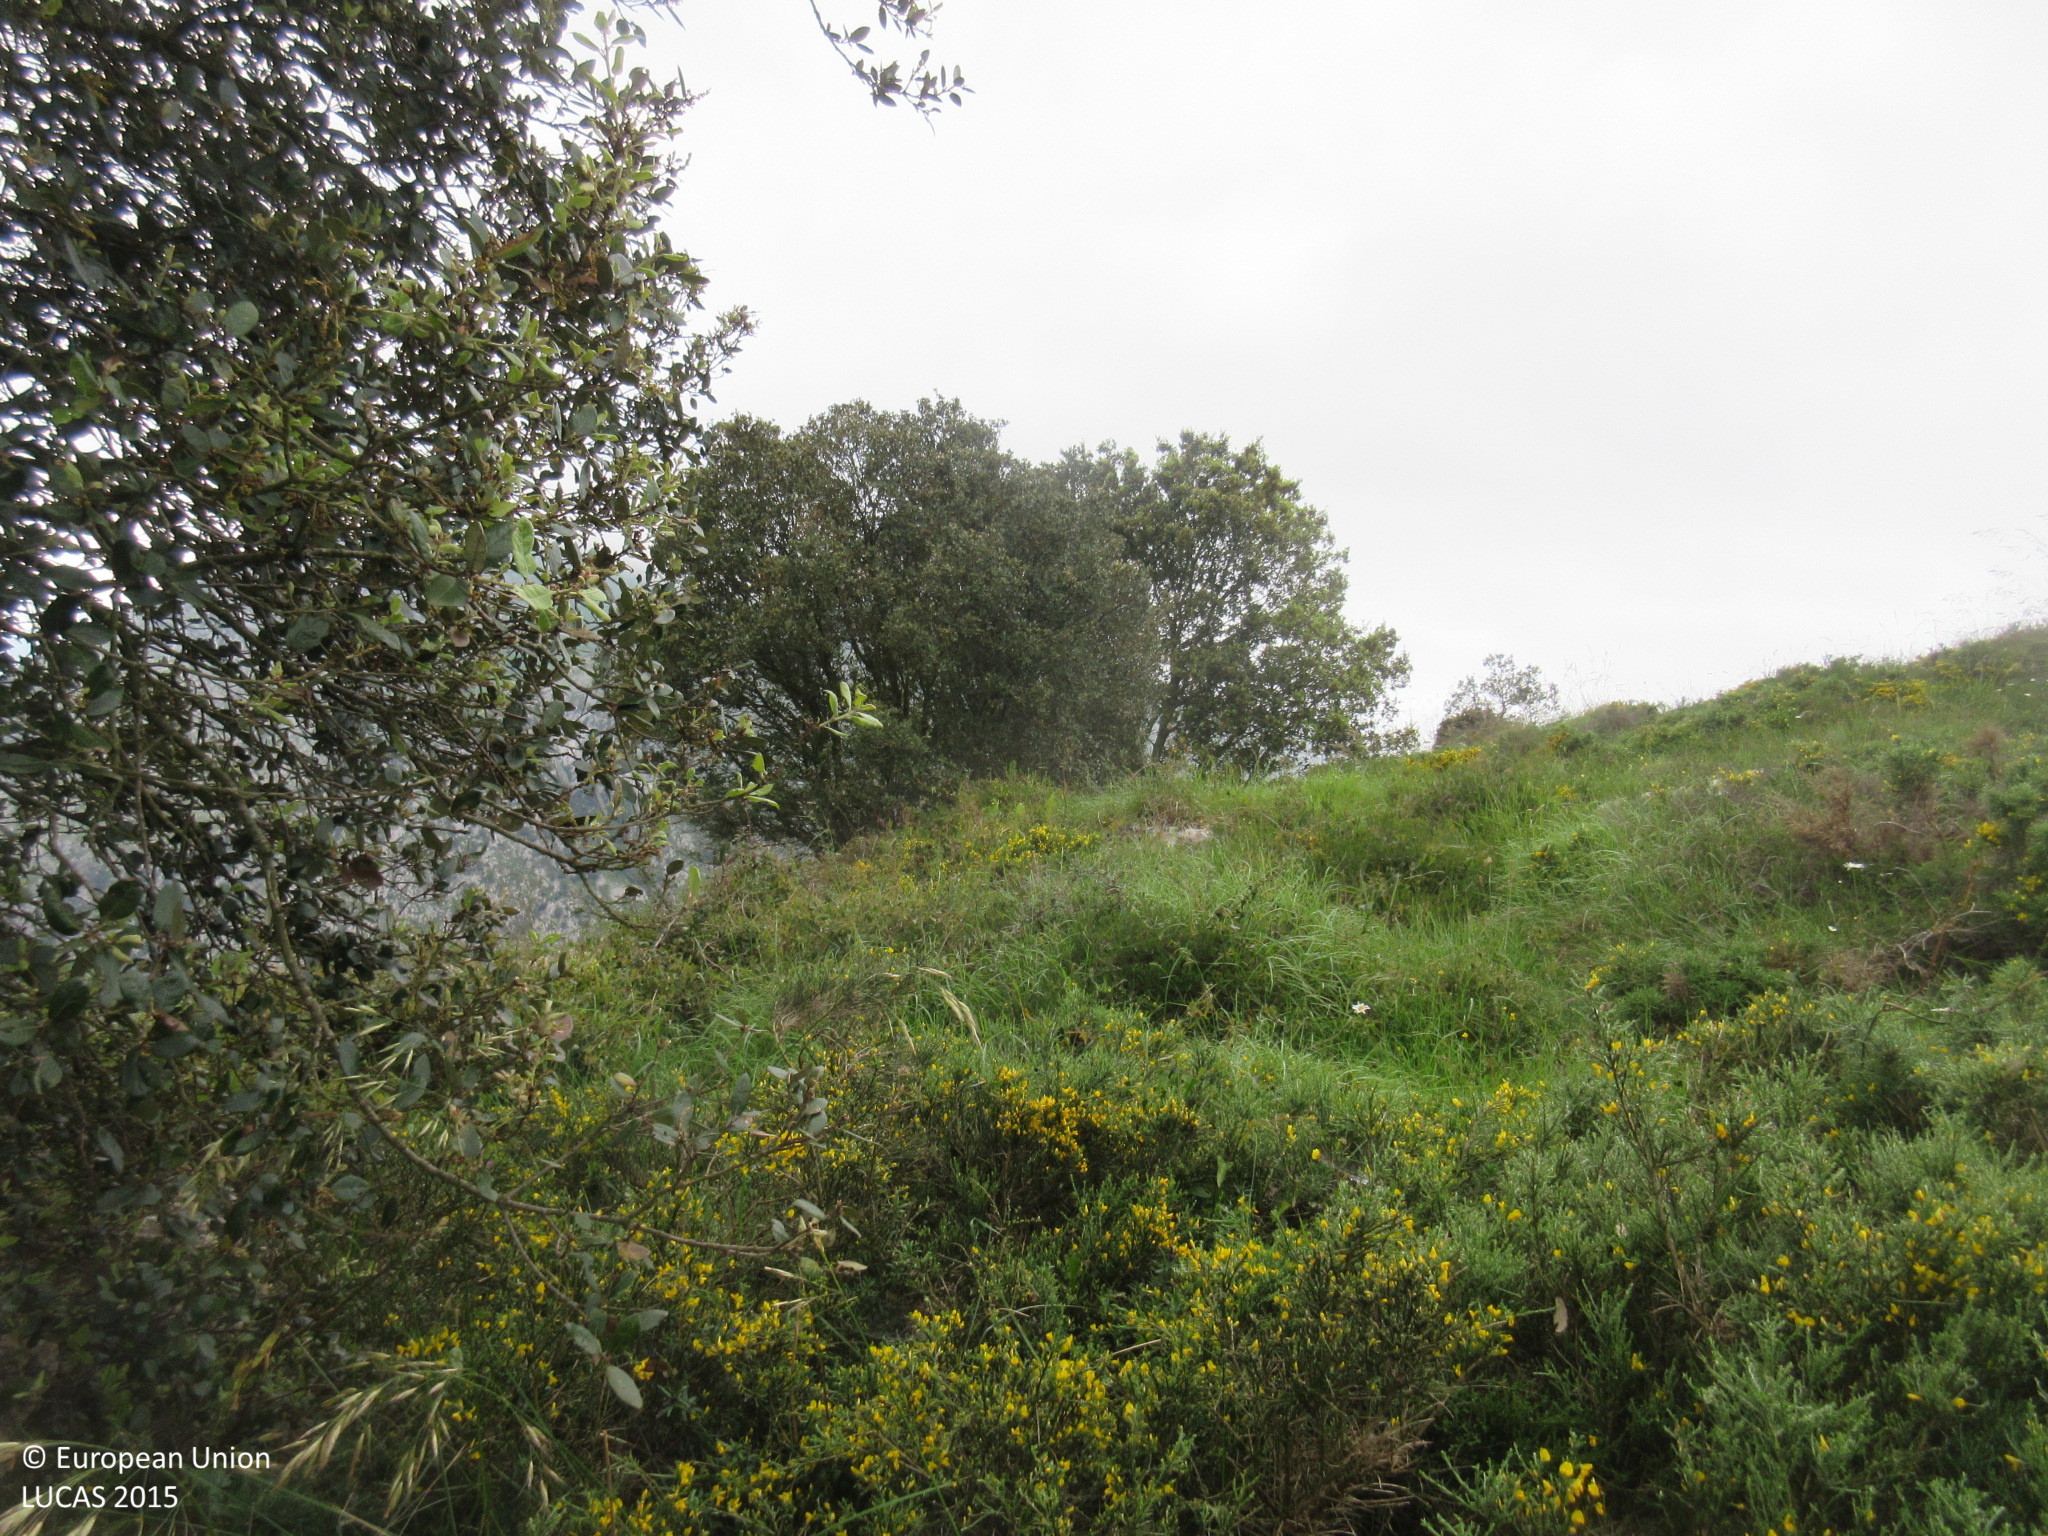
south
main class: Shrubland
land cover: Shrubland with sparse tree cover
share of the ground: > 75 %
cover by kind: shrubs 95 %, broadleaved forest trees 5 %
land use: Semi-natural and natural areas not in use
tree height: < 5 m
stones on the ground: > 50 %
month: May
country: ES
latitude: 43.3117
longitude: -4.5977
